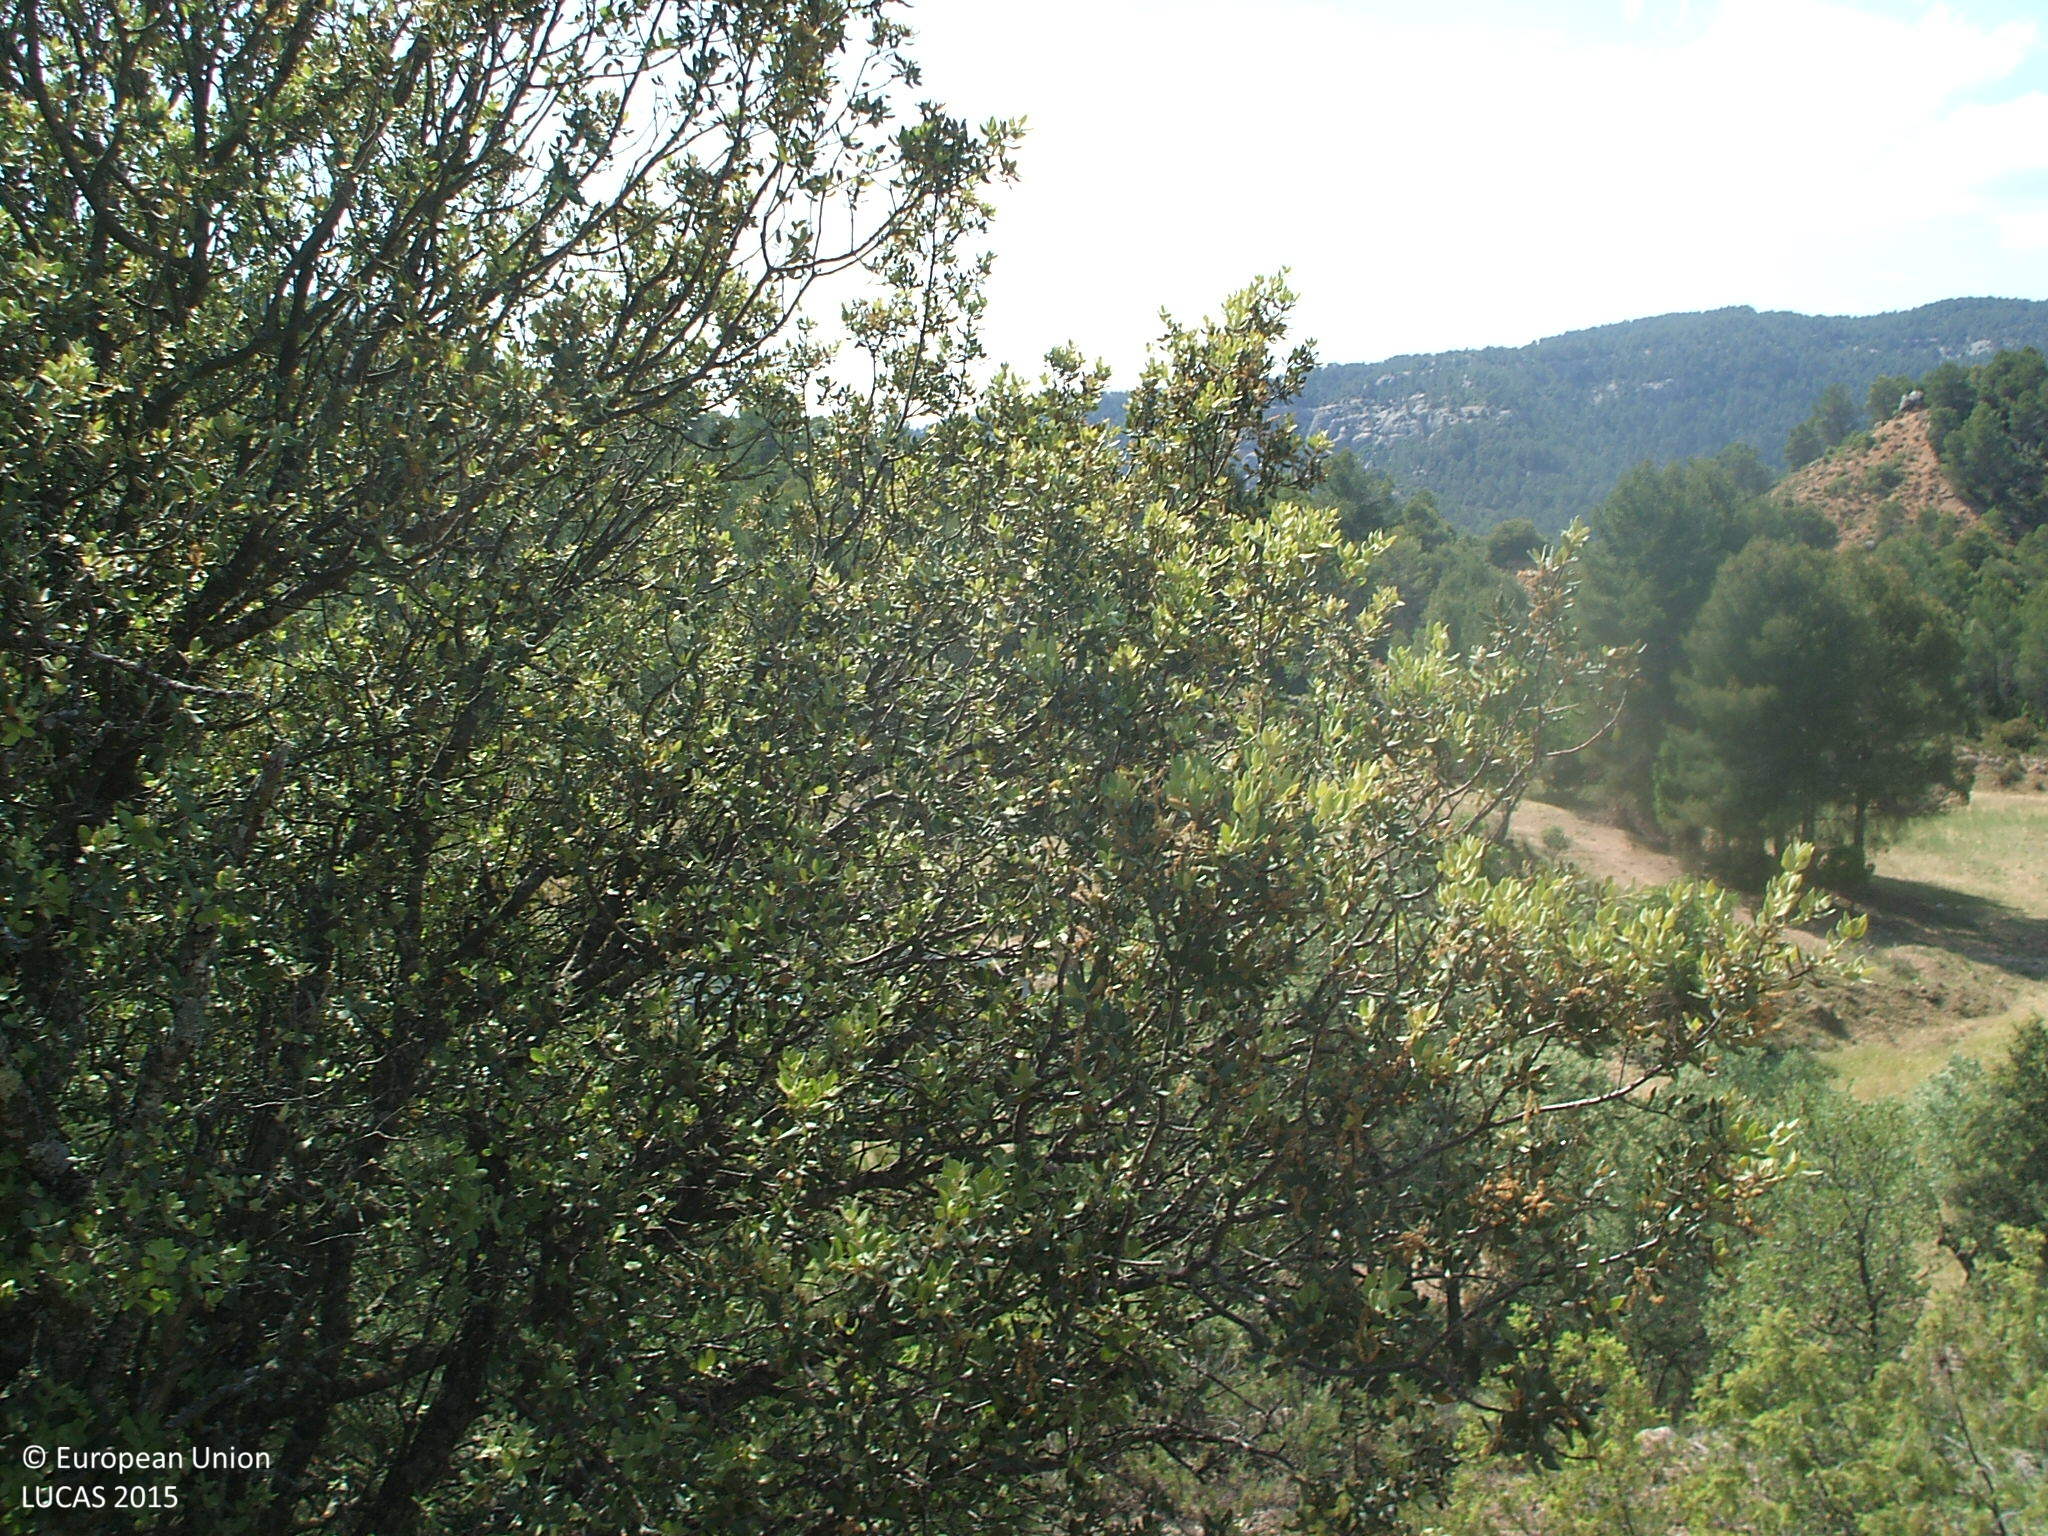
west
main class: Woodland
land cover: Pine dominated mixed woodland
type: coniferous forest of the mediterranean region
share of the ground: 25 - 50 %
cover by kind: consolidated bare surface 50 %, shrubs 20 %, coniferous forest trees 15 %, broadleaved forest trees 15 %
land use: Semi-natural and natural areas not in use
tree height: > 5 m
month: May
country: ES
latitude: 40.7408
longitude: -0.1575
